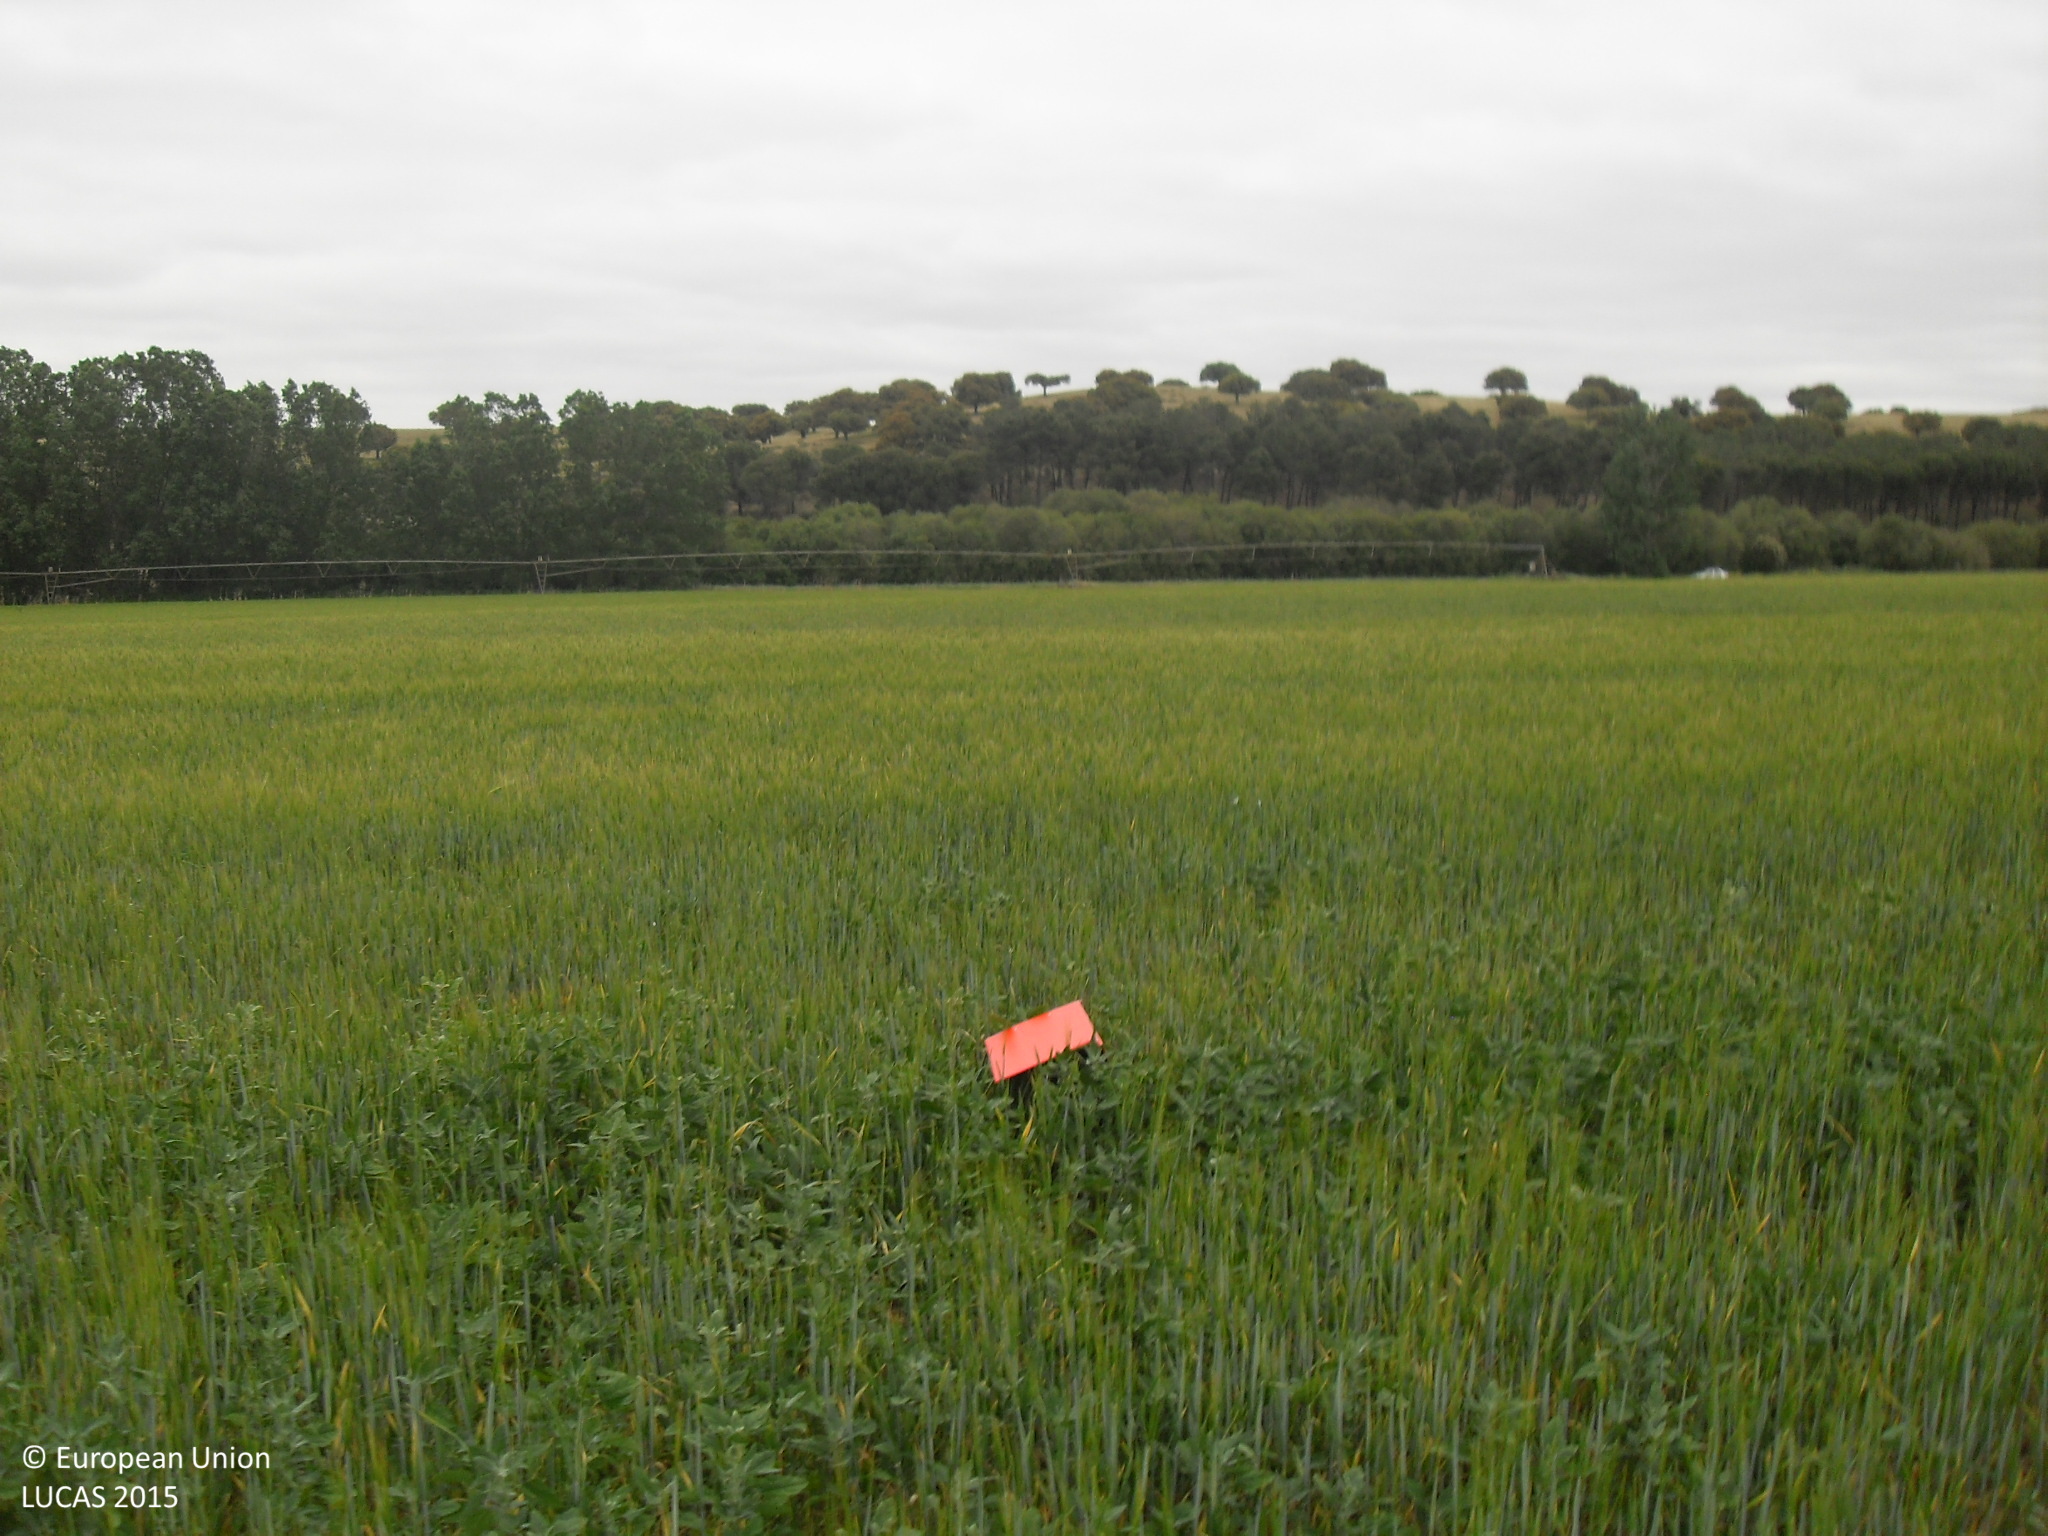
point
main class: Cropland
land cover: Barley
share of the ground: > 75 %
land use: Agriculture (excluding fallow land and kitchen gardens)
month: May
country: ES
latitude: 40.6750
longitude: -5.6537
